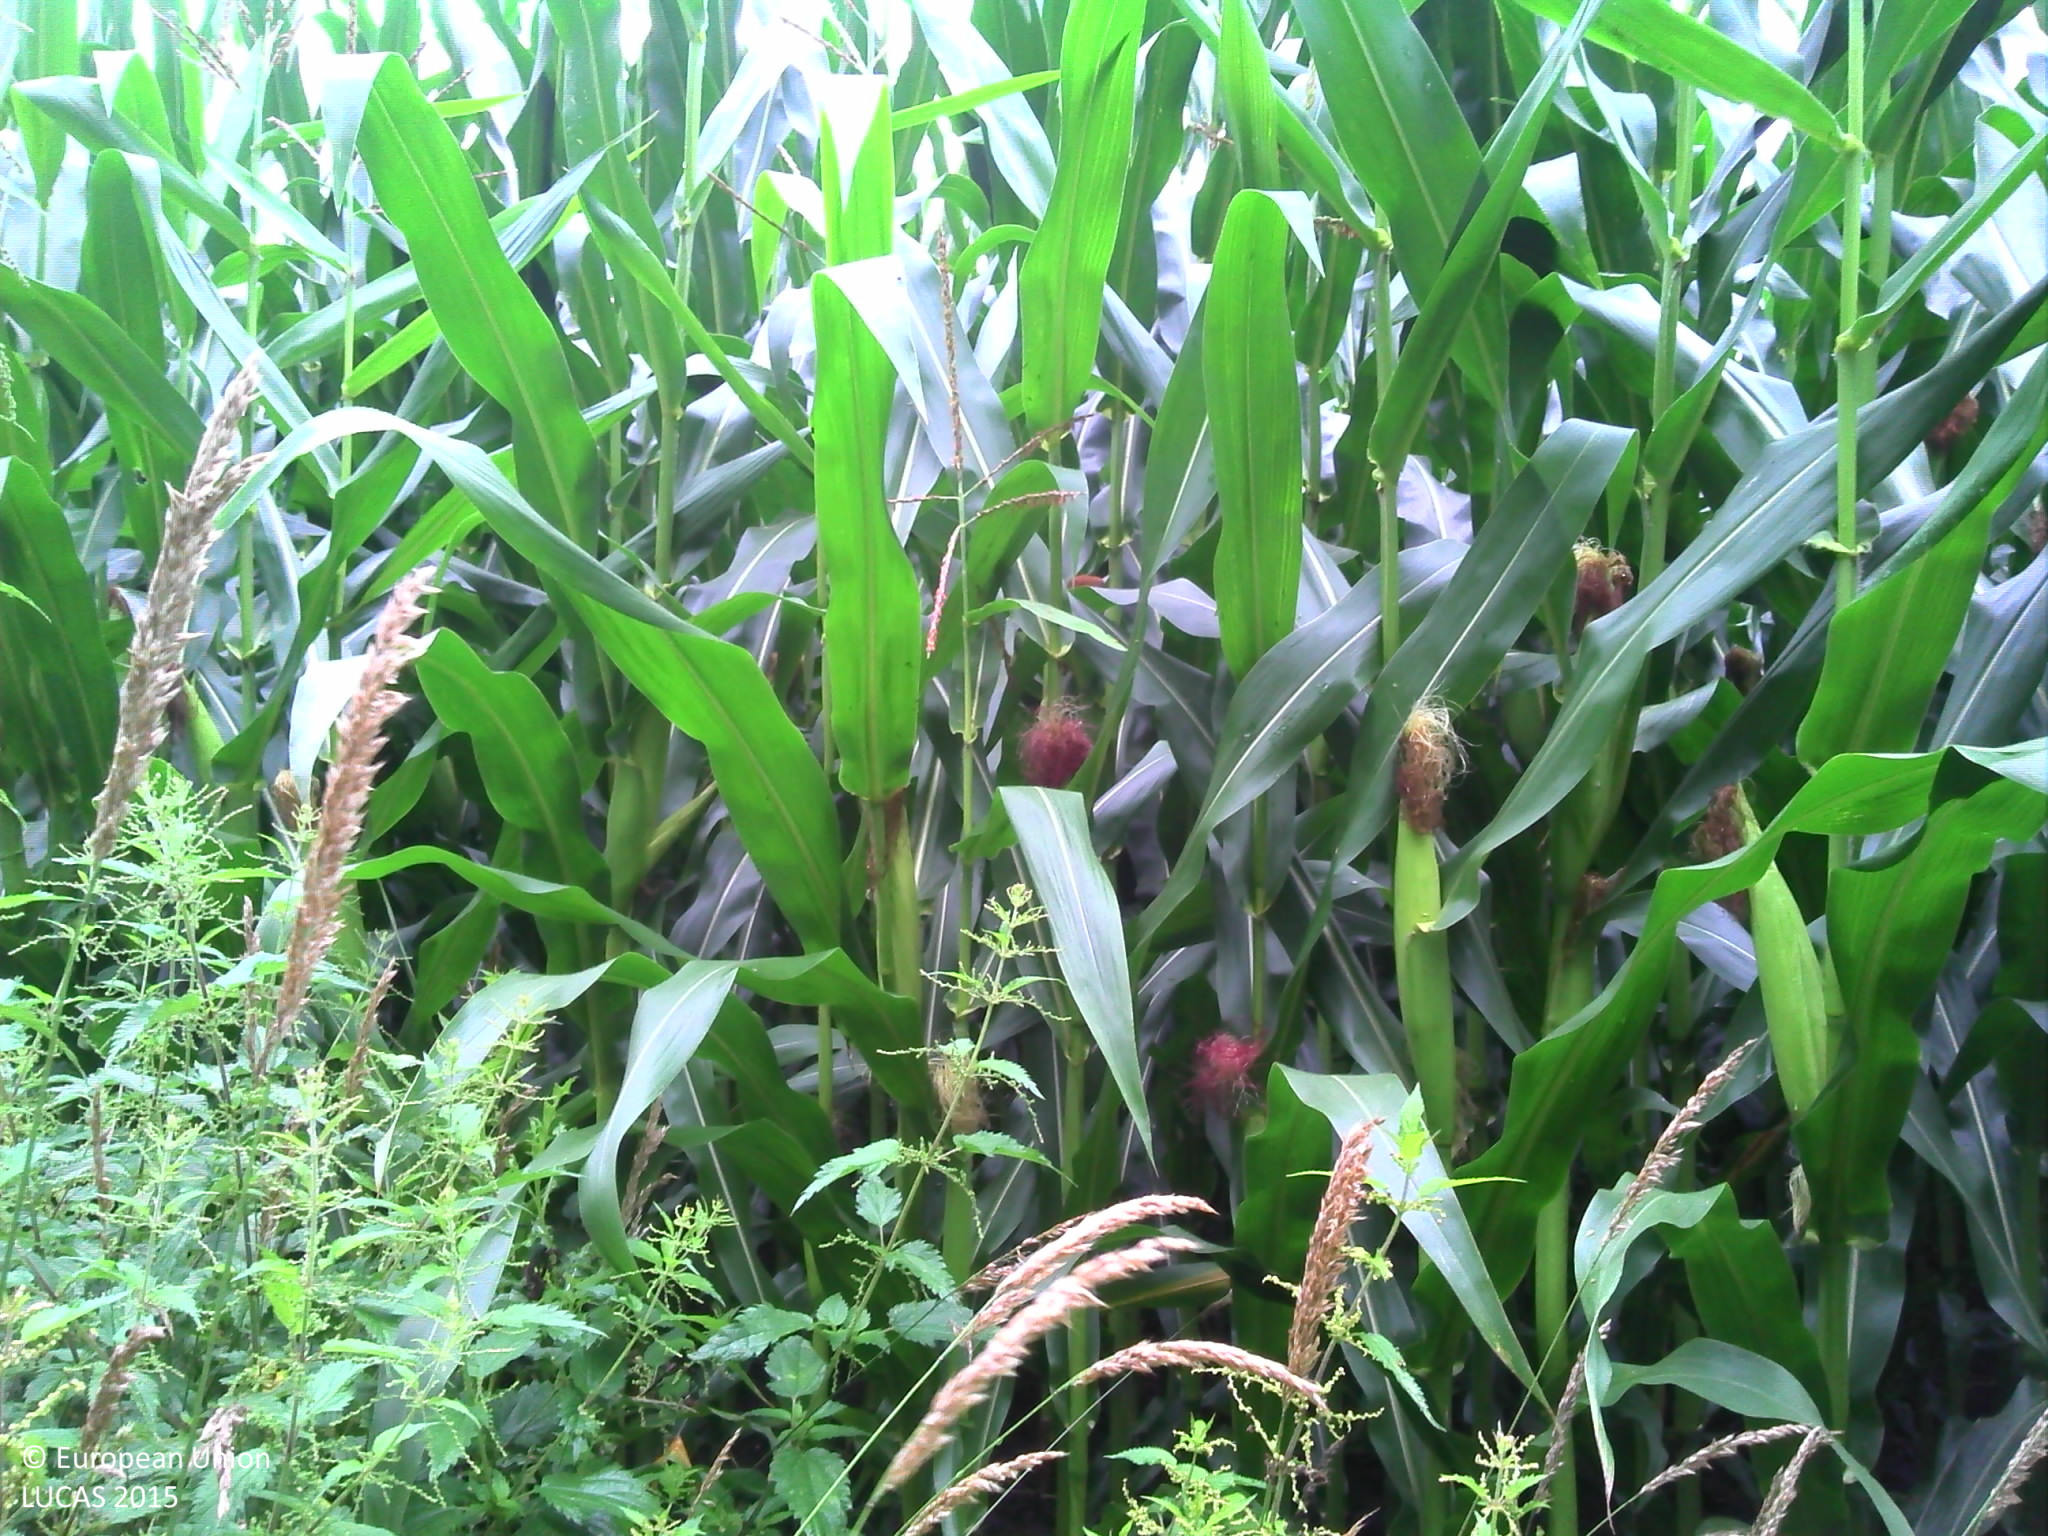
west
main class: Cropland
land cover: Maize
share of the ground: > 75 %
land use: Agriculture (excluding fallow land and kitchen gardens)
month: August
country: BE
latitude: 51.3530
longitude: 4.9857
